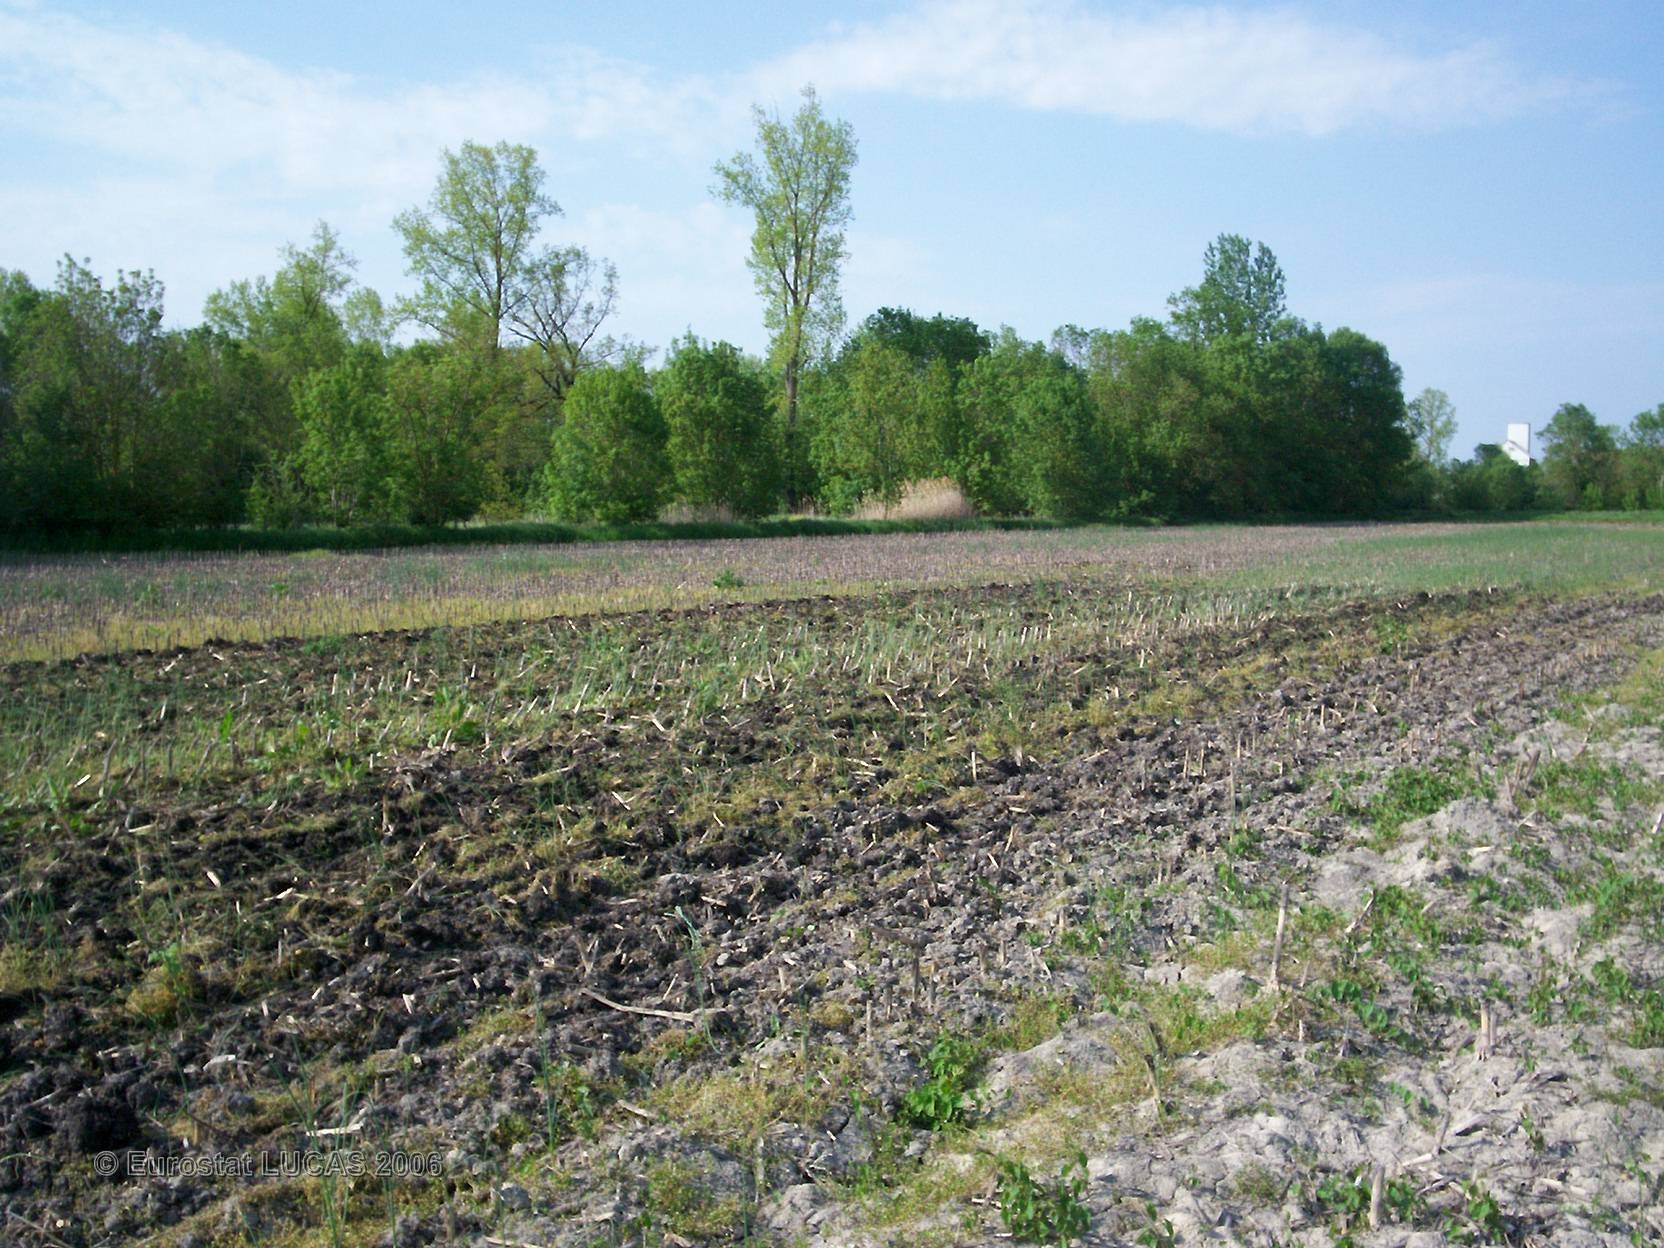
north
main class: Cropland
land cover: Maize
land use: Agriculture (excluding fallow land and kitchen gardens)
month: May
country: FR
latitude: 46.2460
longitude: -0.7279
